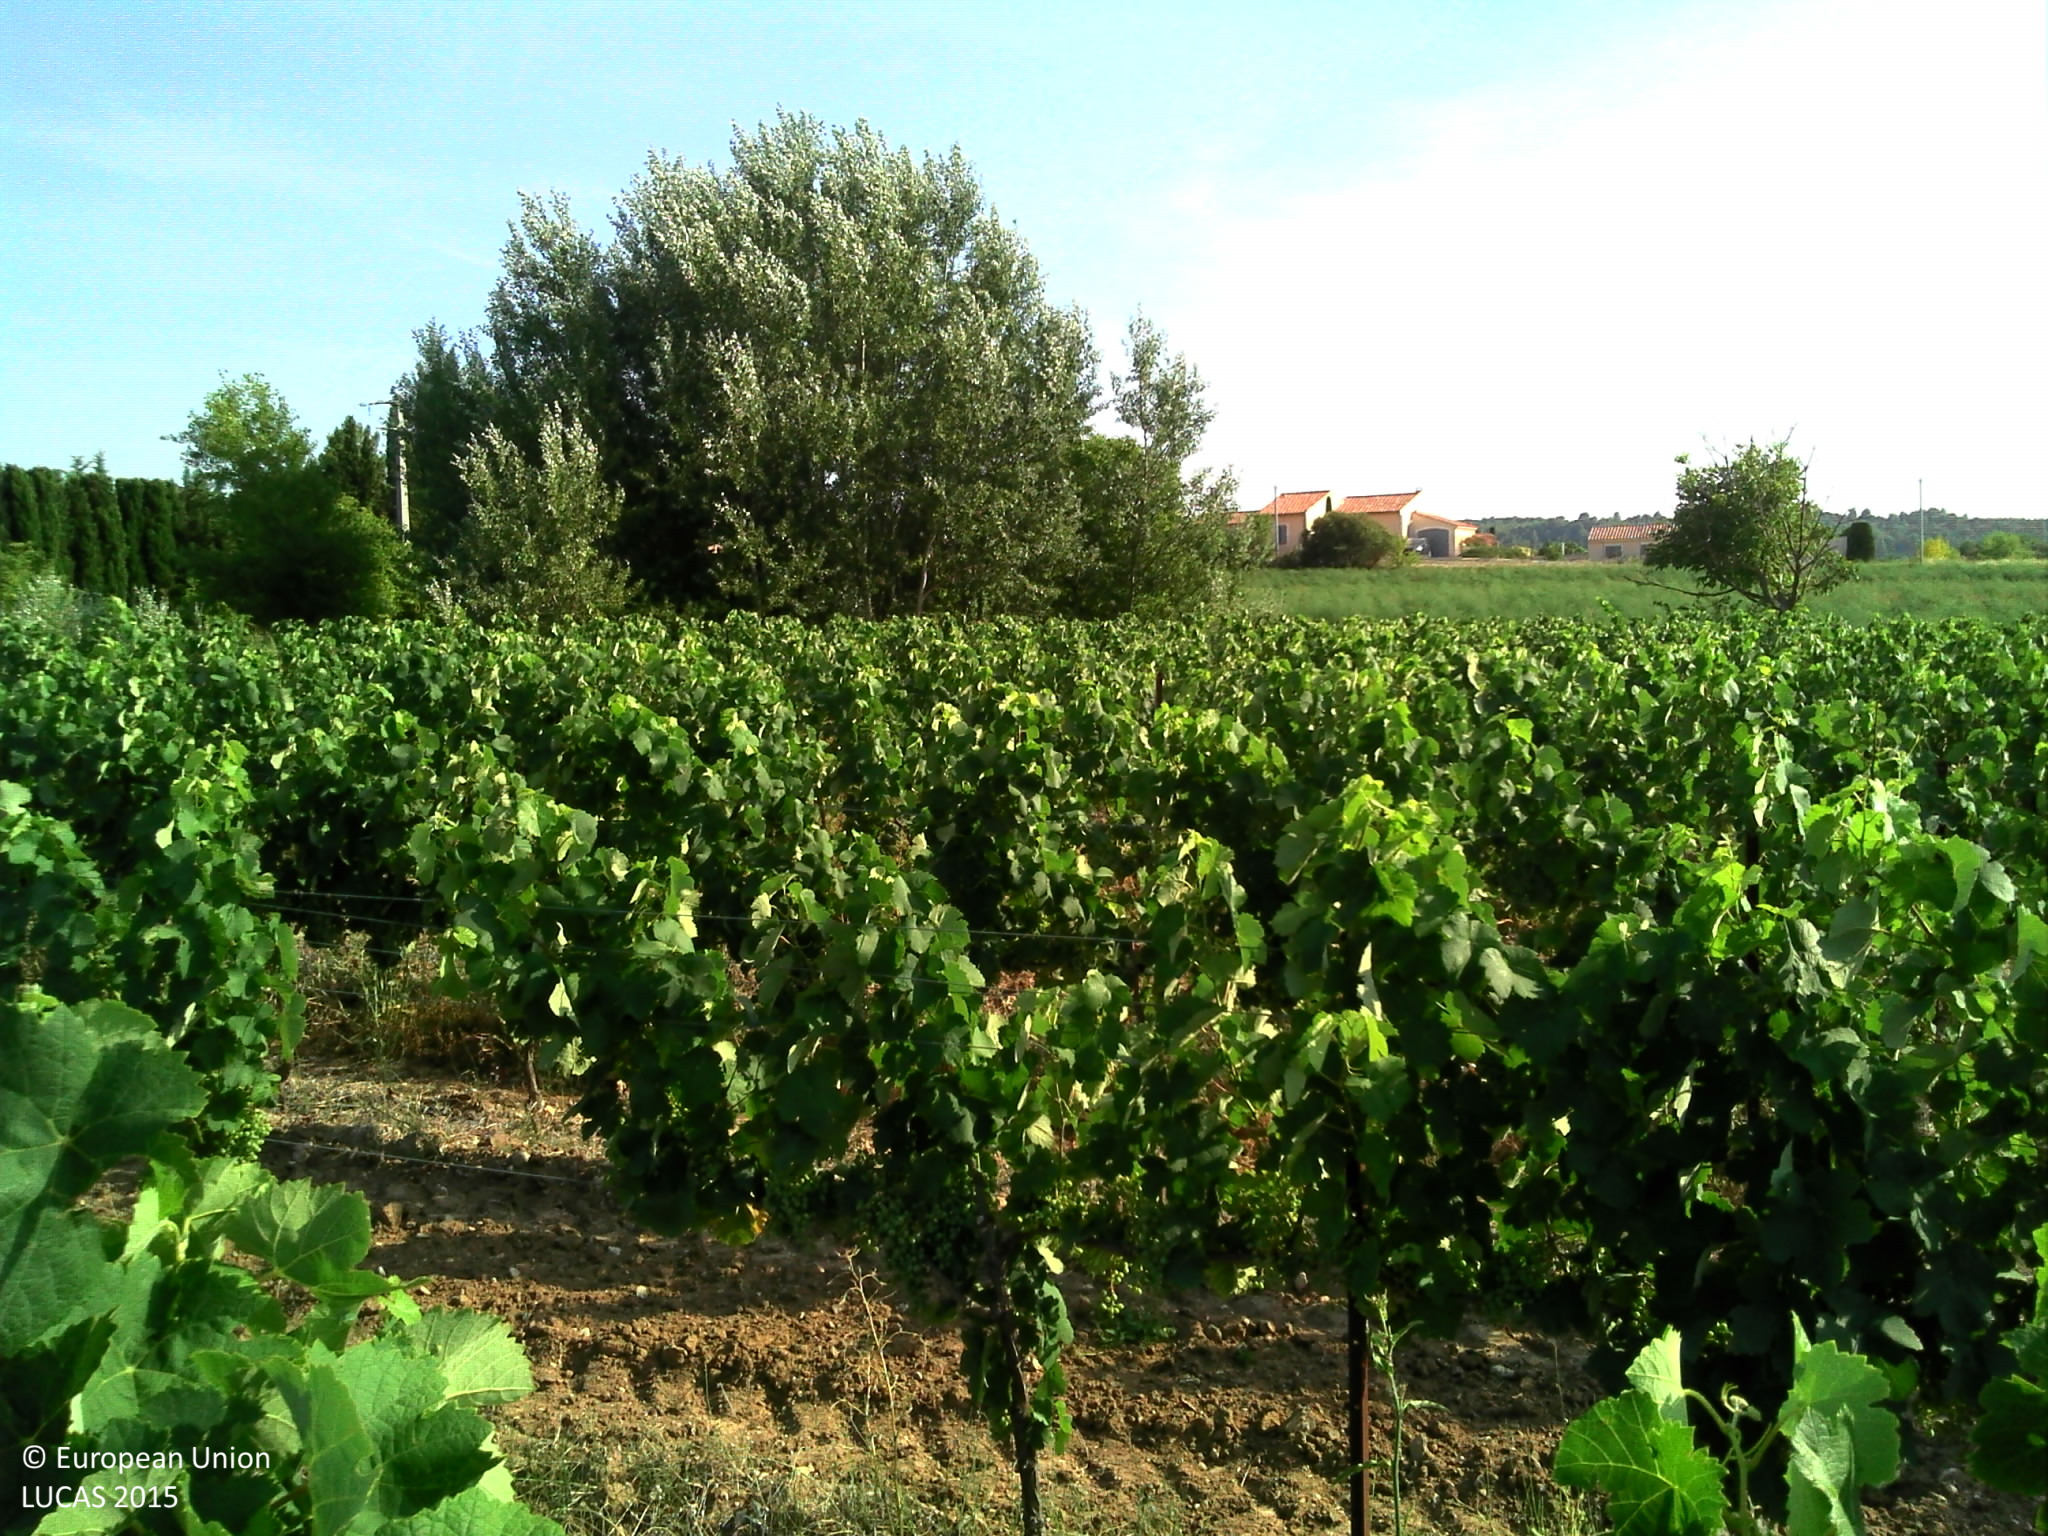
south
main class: Cropland
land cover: Vineyards
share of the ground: 25 - 50 %
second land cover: Other bare soil
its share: > 75 %
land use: Agriculture (excluding fallow land and kitchen gardens)
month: July
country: FR
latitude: 44.1118
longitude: 5.1728
